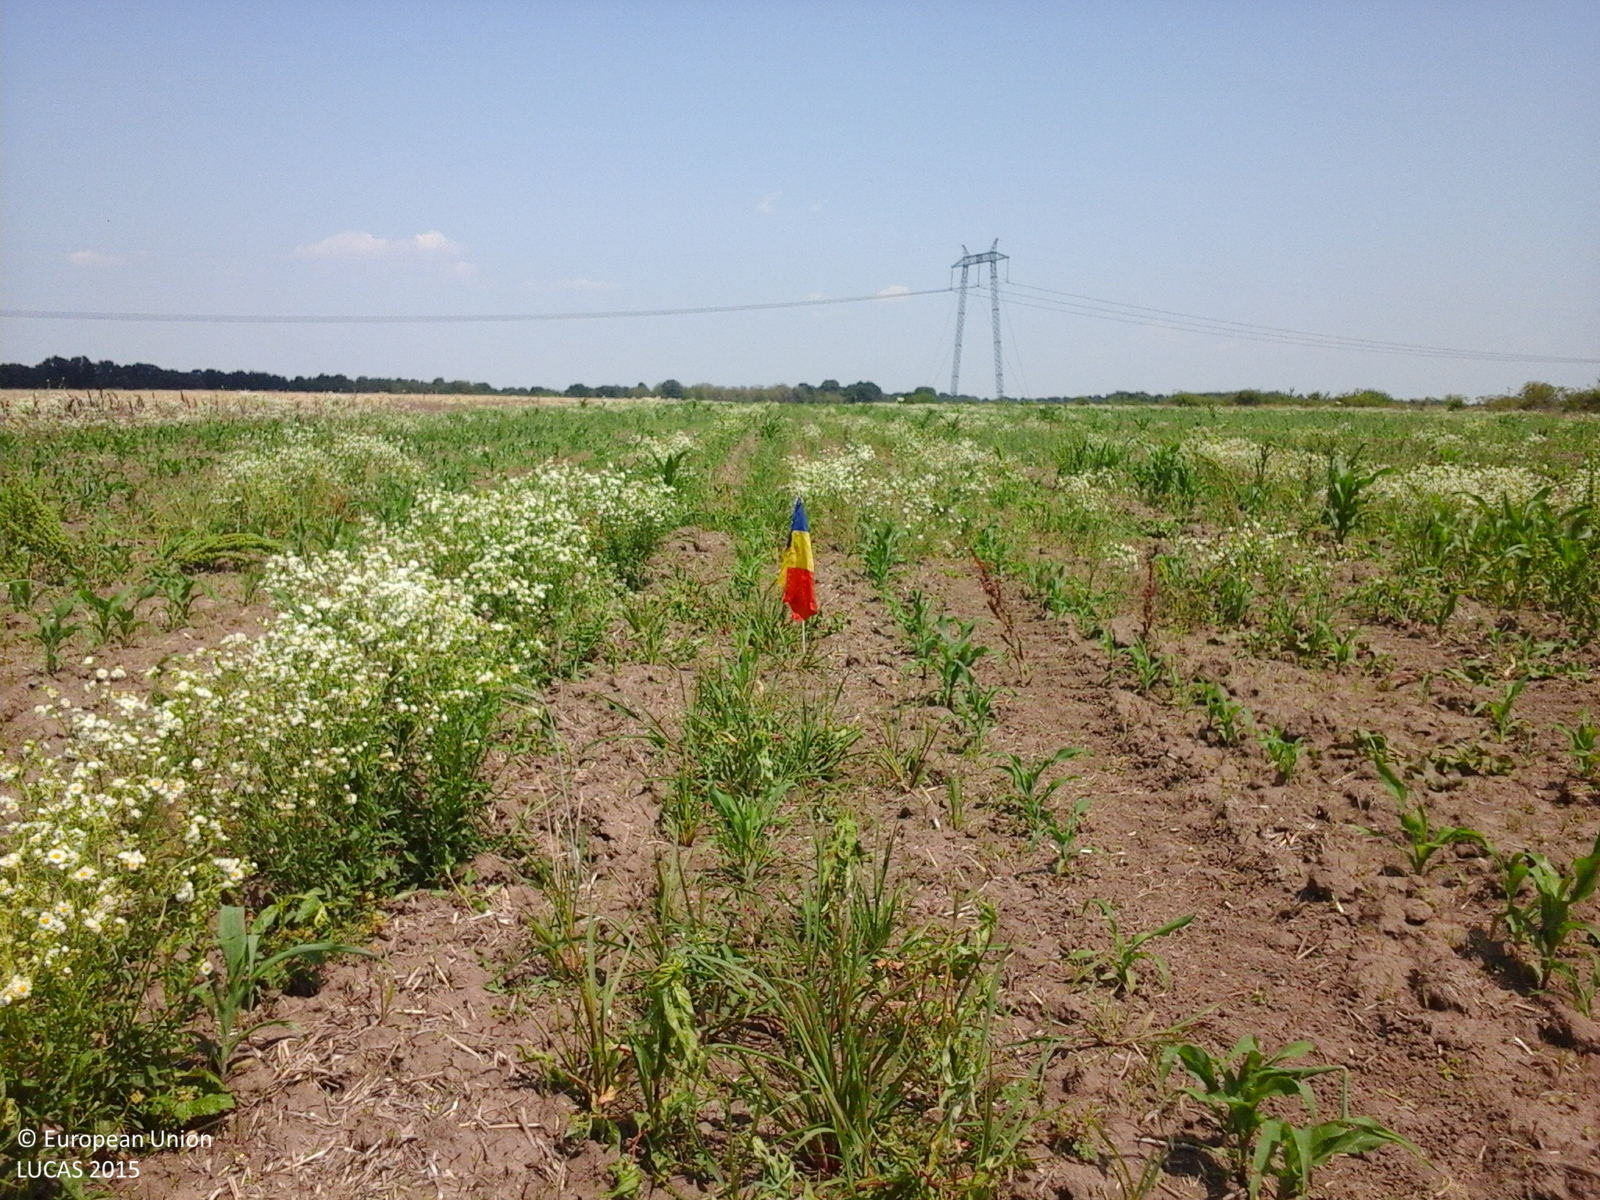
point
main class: Cropland
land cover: Maize
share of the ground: 10 - 25 %
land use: Agriculture (excluding fallow land and kitchen gardens)
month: July
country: RO
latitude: 44.6494
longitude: 24.7159
